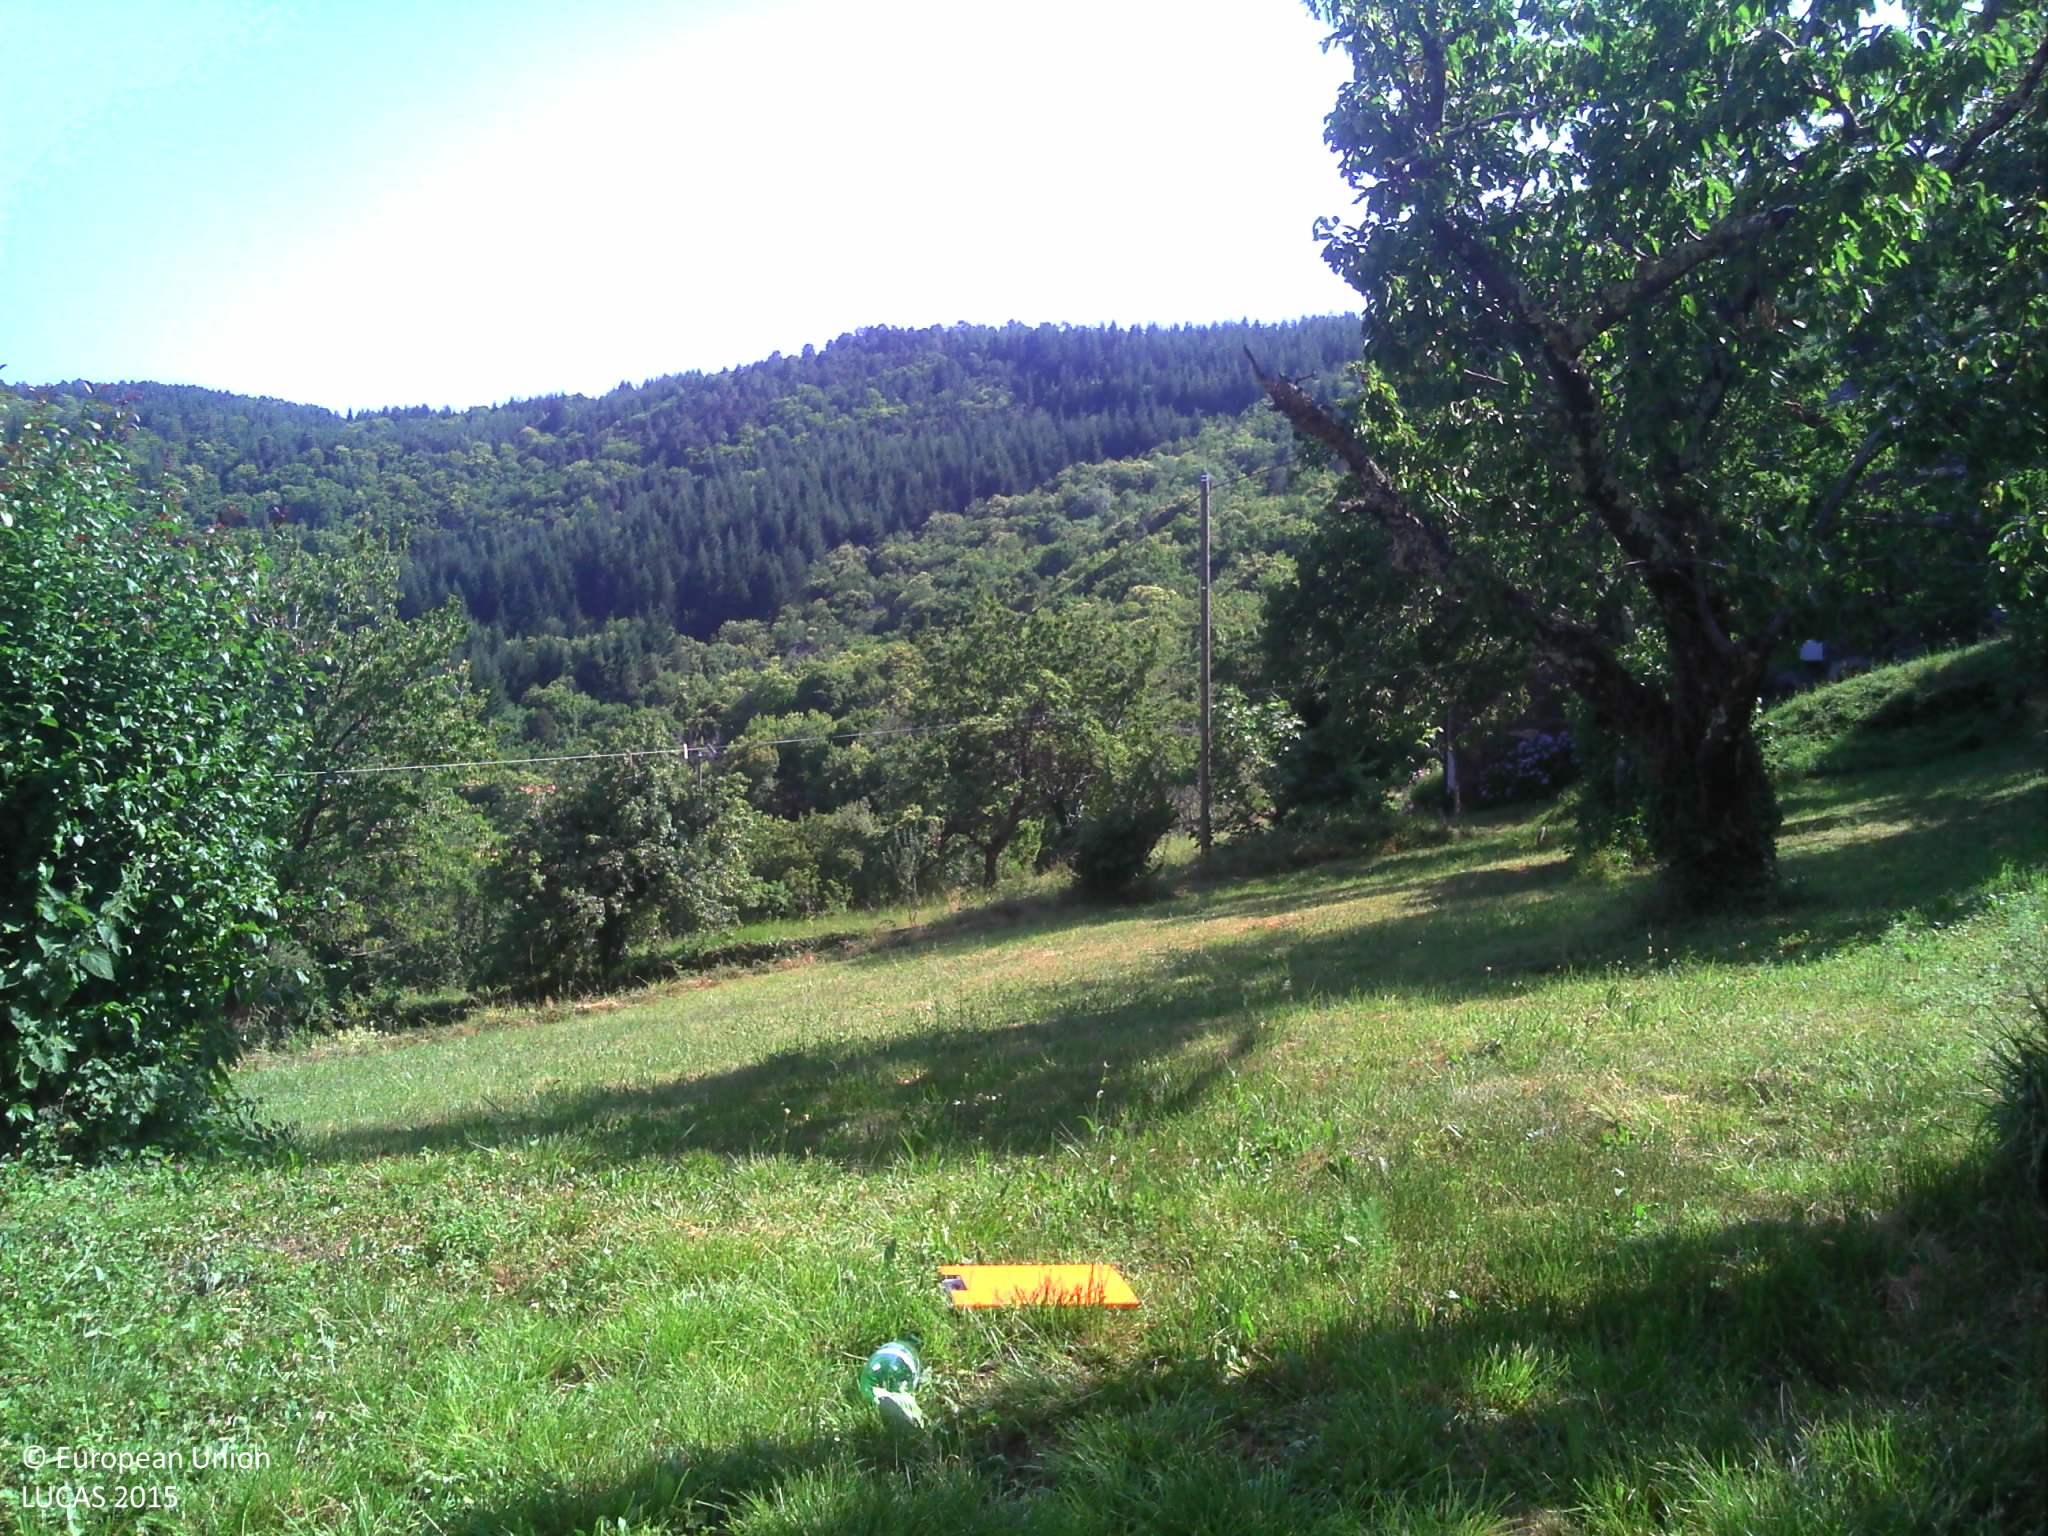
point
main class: Cropland
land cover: Cherry fruit
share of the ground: 25 - 50 %
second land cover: Grassland without tree/shrub cover
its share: 25 - 50 %
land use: Kitchen garden
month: July
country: FR
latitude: 44.2274
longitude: 3.9354
